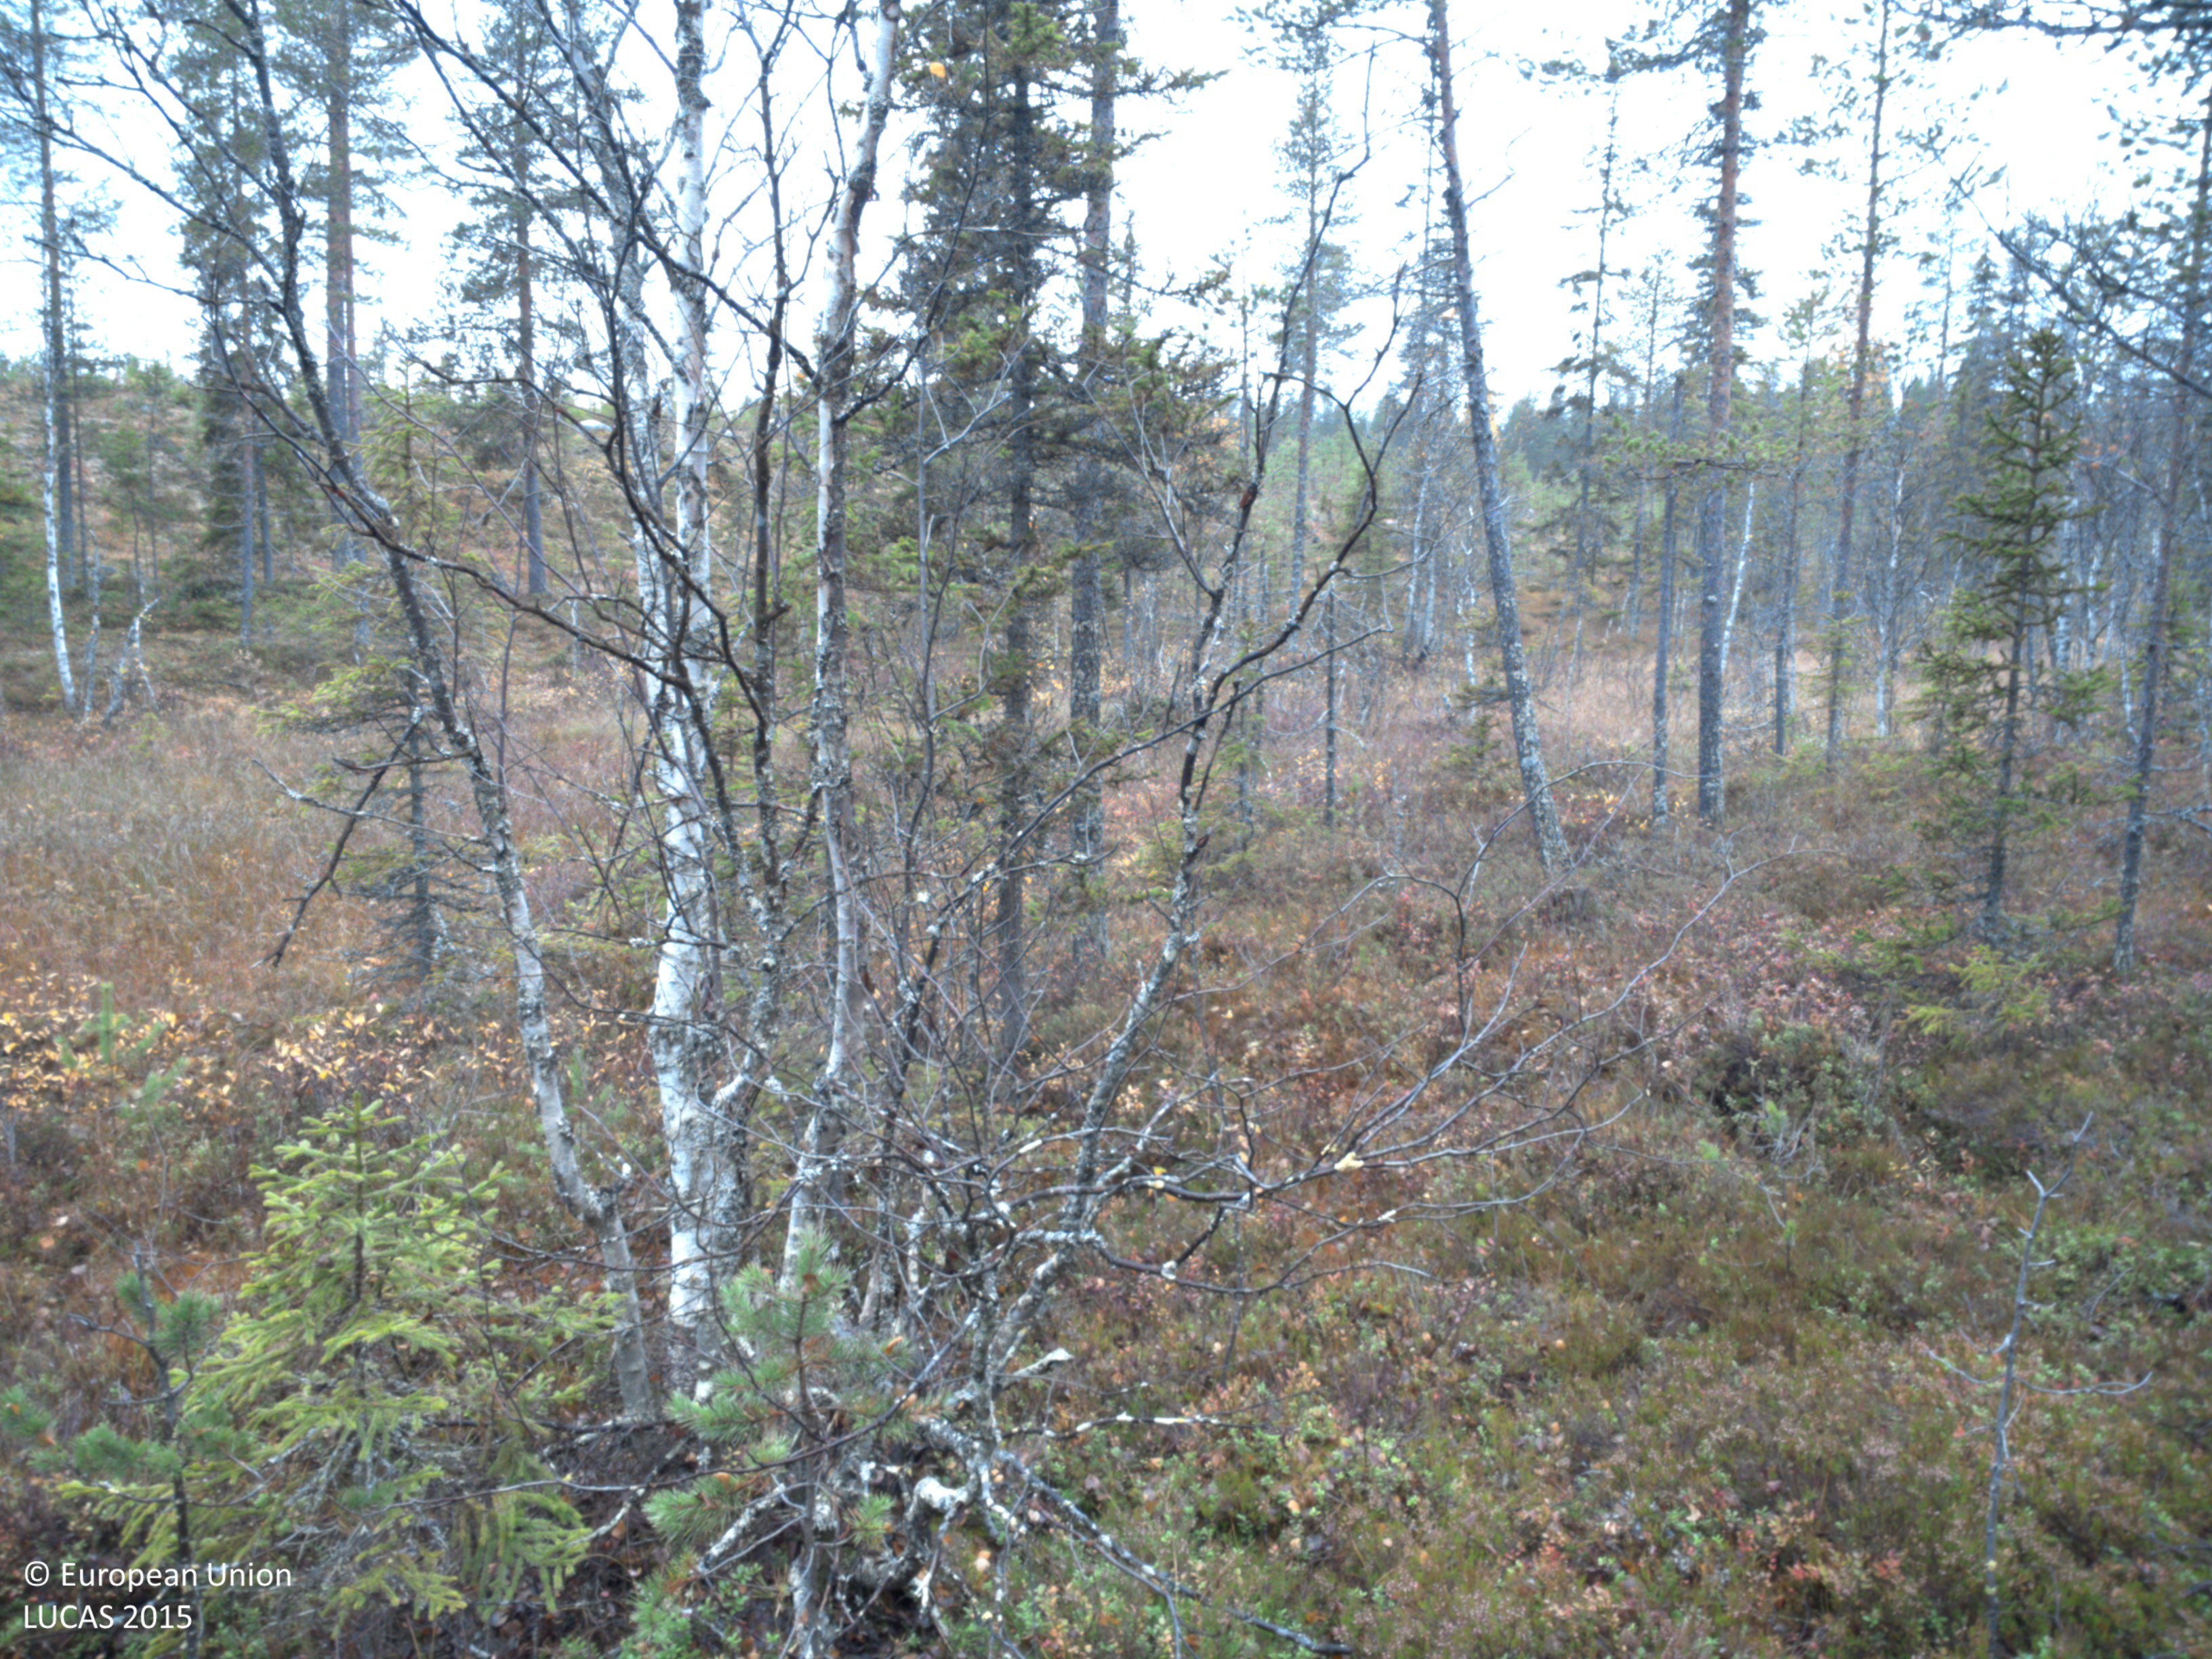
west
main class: Woodland
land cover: Spruce dominated mixed woodland
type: boreal forest
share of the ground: 25 - 50 %
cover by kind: coniferous forest trees 30 %, shrubs 30 %, broadleaved forest trees 20 %, herbaceous plants 10 %, lichens and mosses 10 %
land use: Forestry
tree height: < 5 m
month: September
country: SE
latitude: 64.8986
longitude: 18.8179
